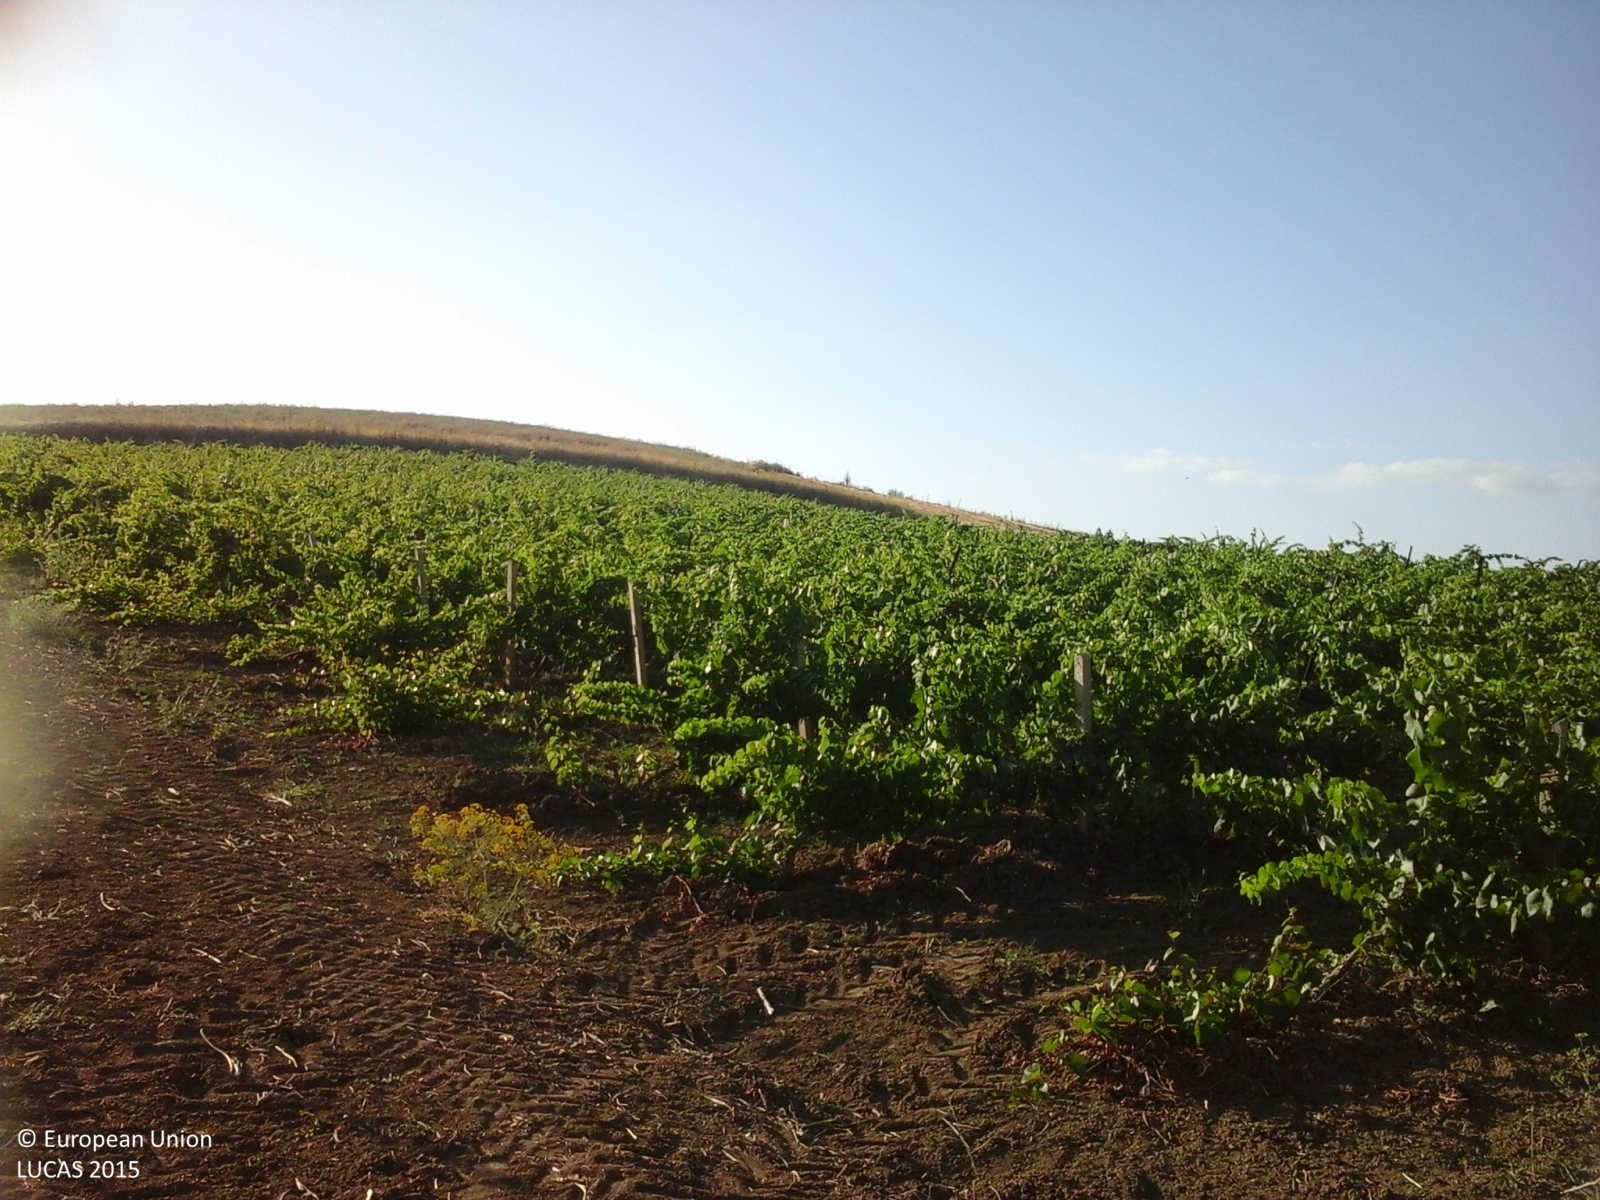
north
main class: Cropland
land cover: Durum wheat
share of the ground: > 75 %
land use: Agriculture (excluding fallow land and kitchen gardens)
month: June
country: IT
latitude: 37.6805
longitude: 13.0499
